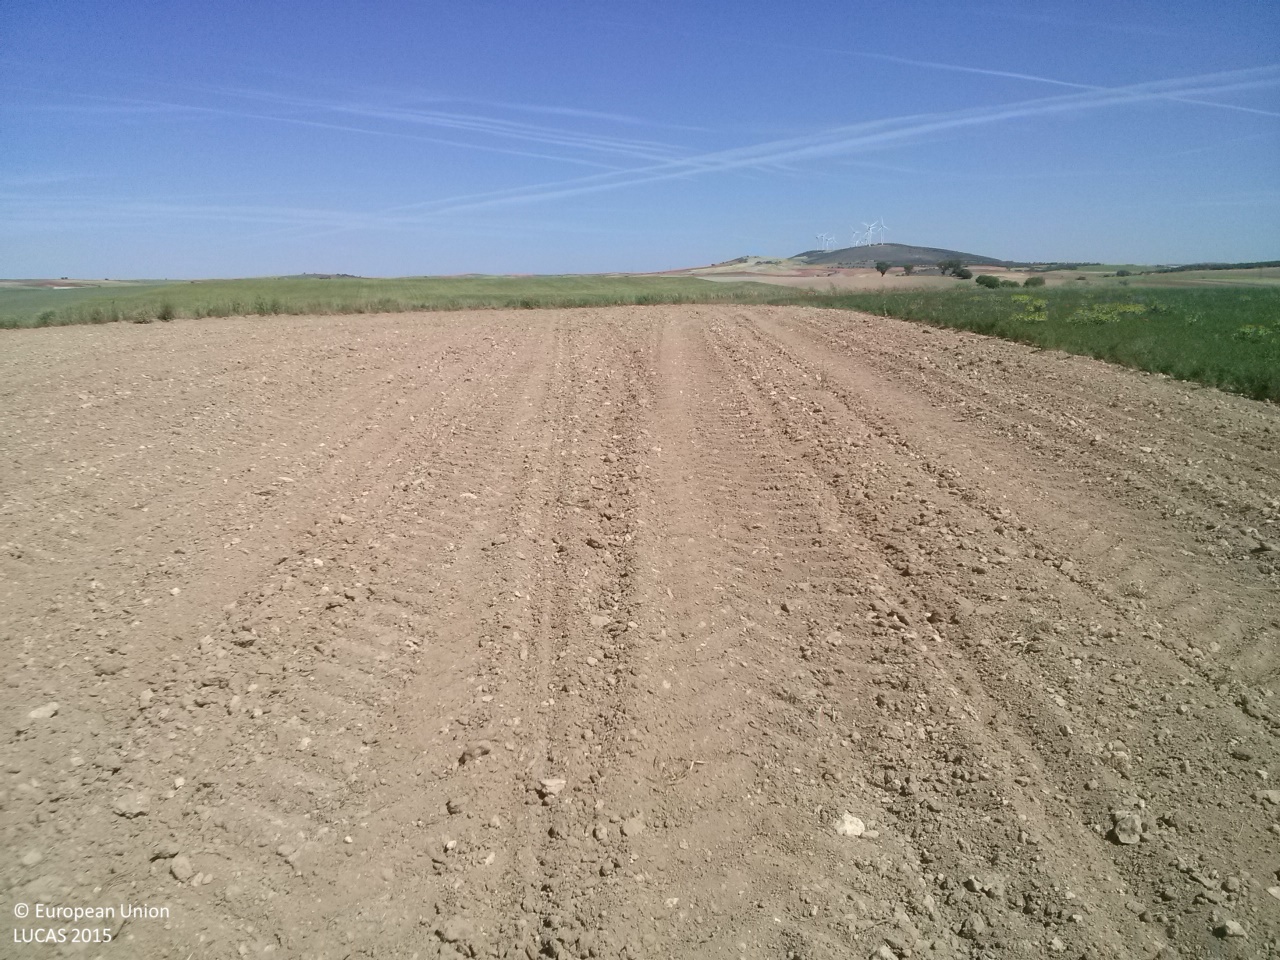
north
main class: Cropland
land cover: Sunflower
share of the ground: < 10 %
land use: Agriculture (excluding fallow land and kitchen gardens)
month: May
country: ES
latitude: 39.9450
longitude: -2.7423
